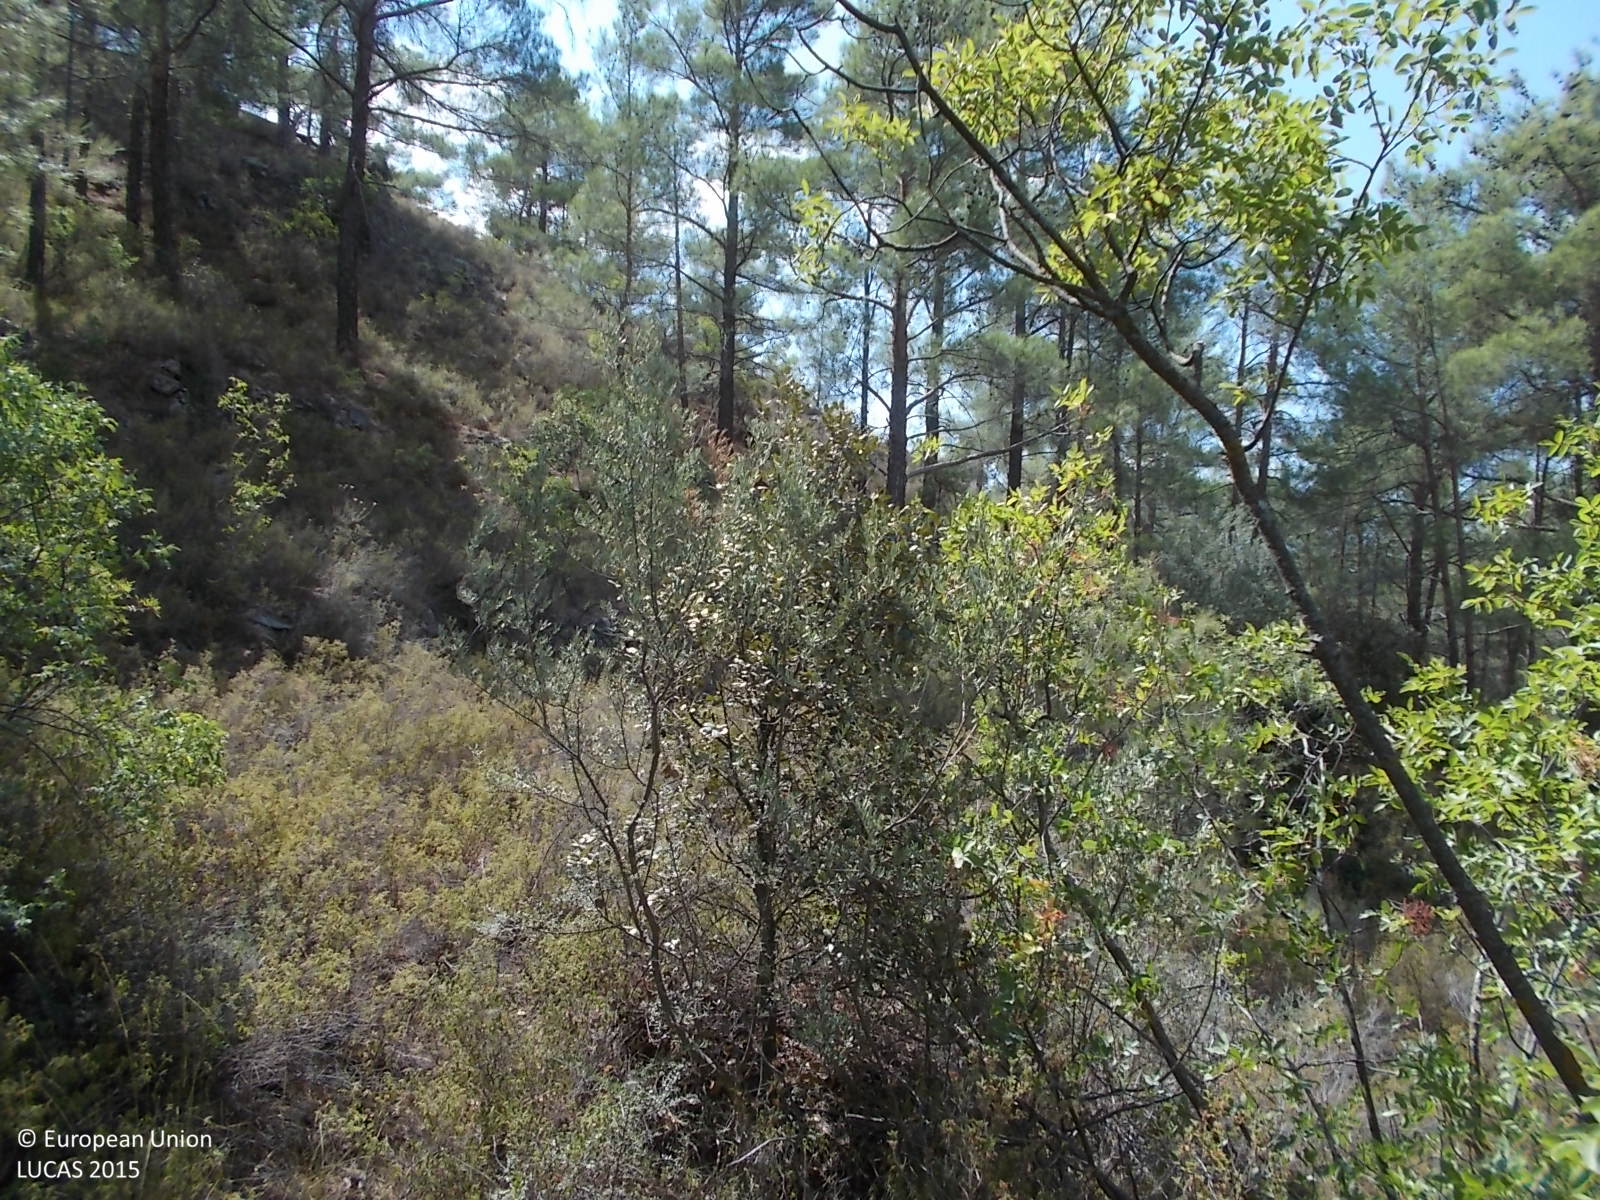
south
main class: Woodland
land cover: Pine dominated mixed woodland
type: coniferous forest of the mediterranean region
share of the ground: 50 - 75 %
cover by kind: coniferous forest trees 45 %, shrubs 25 %, broadleaved forest trees 15 %, unconsolidated bare surface 15 %
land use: Semi-natural and natural areas not in use
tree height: > 5 m
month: September
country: CY
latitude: 34.8648
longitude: 33.0896
